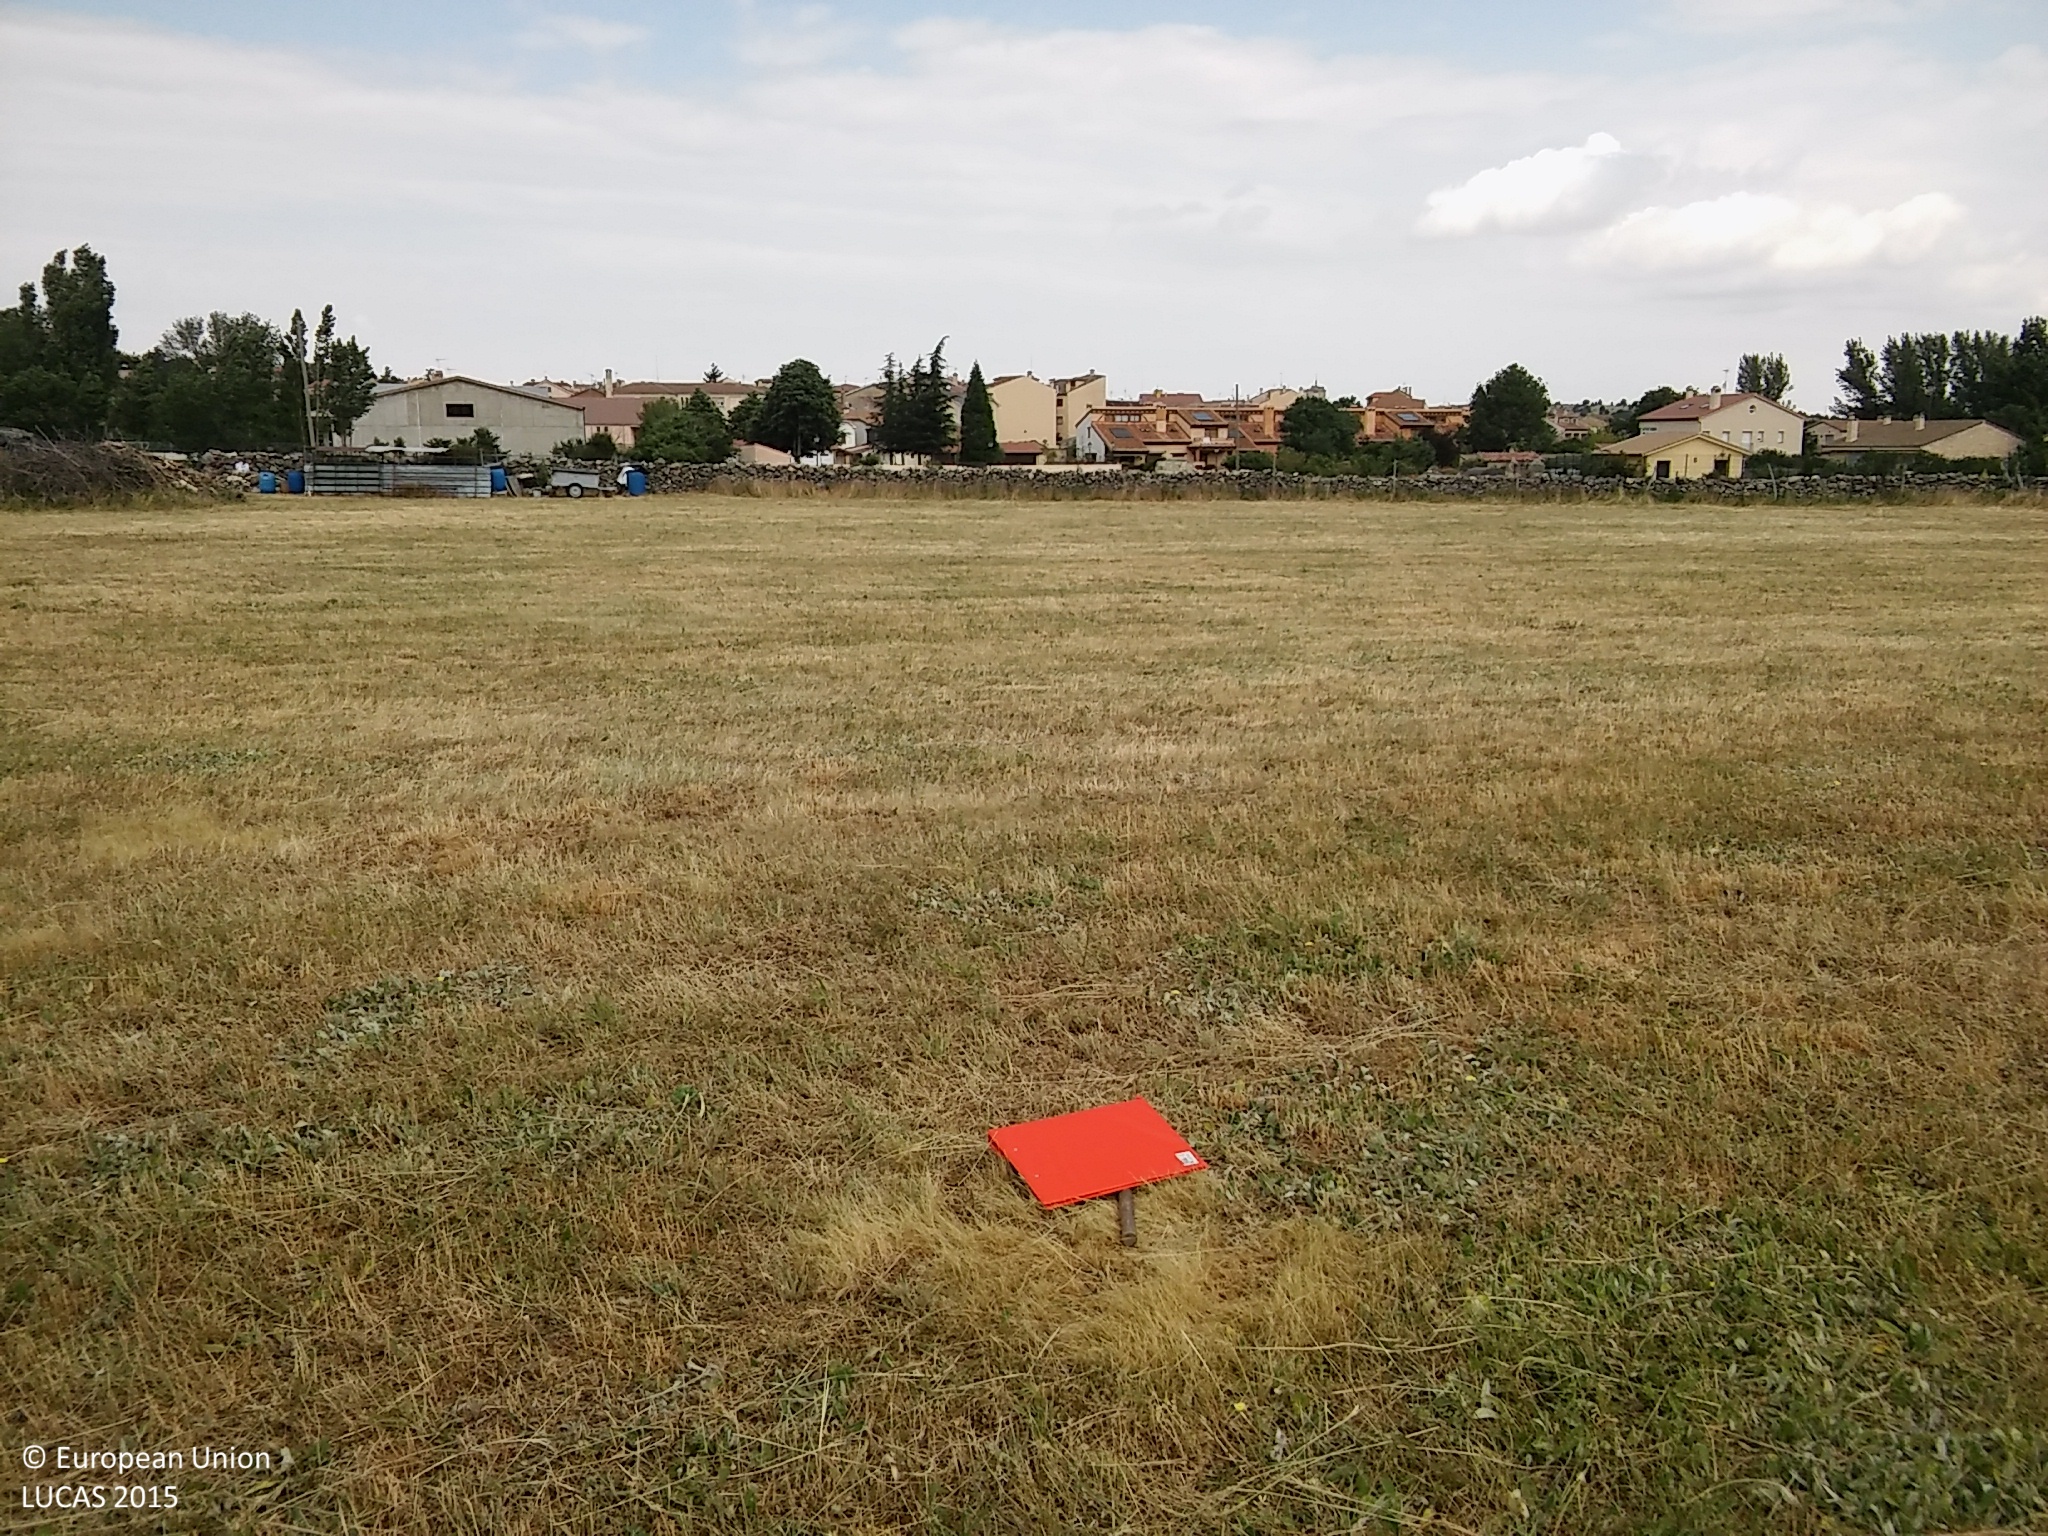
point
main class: Grassland
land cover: Grassland without tree/shrub cover
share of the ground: > 75 %
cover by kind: herbaceous plants 100 %
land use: Agriculture (excluding fallow land and kitchen gardens)
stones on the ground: 10 - 25 %
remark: Harvested field
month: June
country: ES
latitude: 41.1345
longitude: -3.6864
